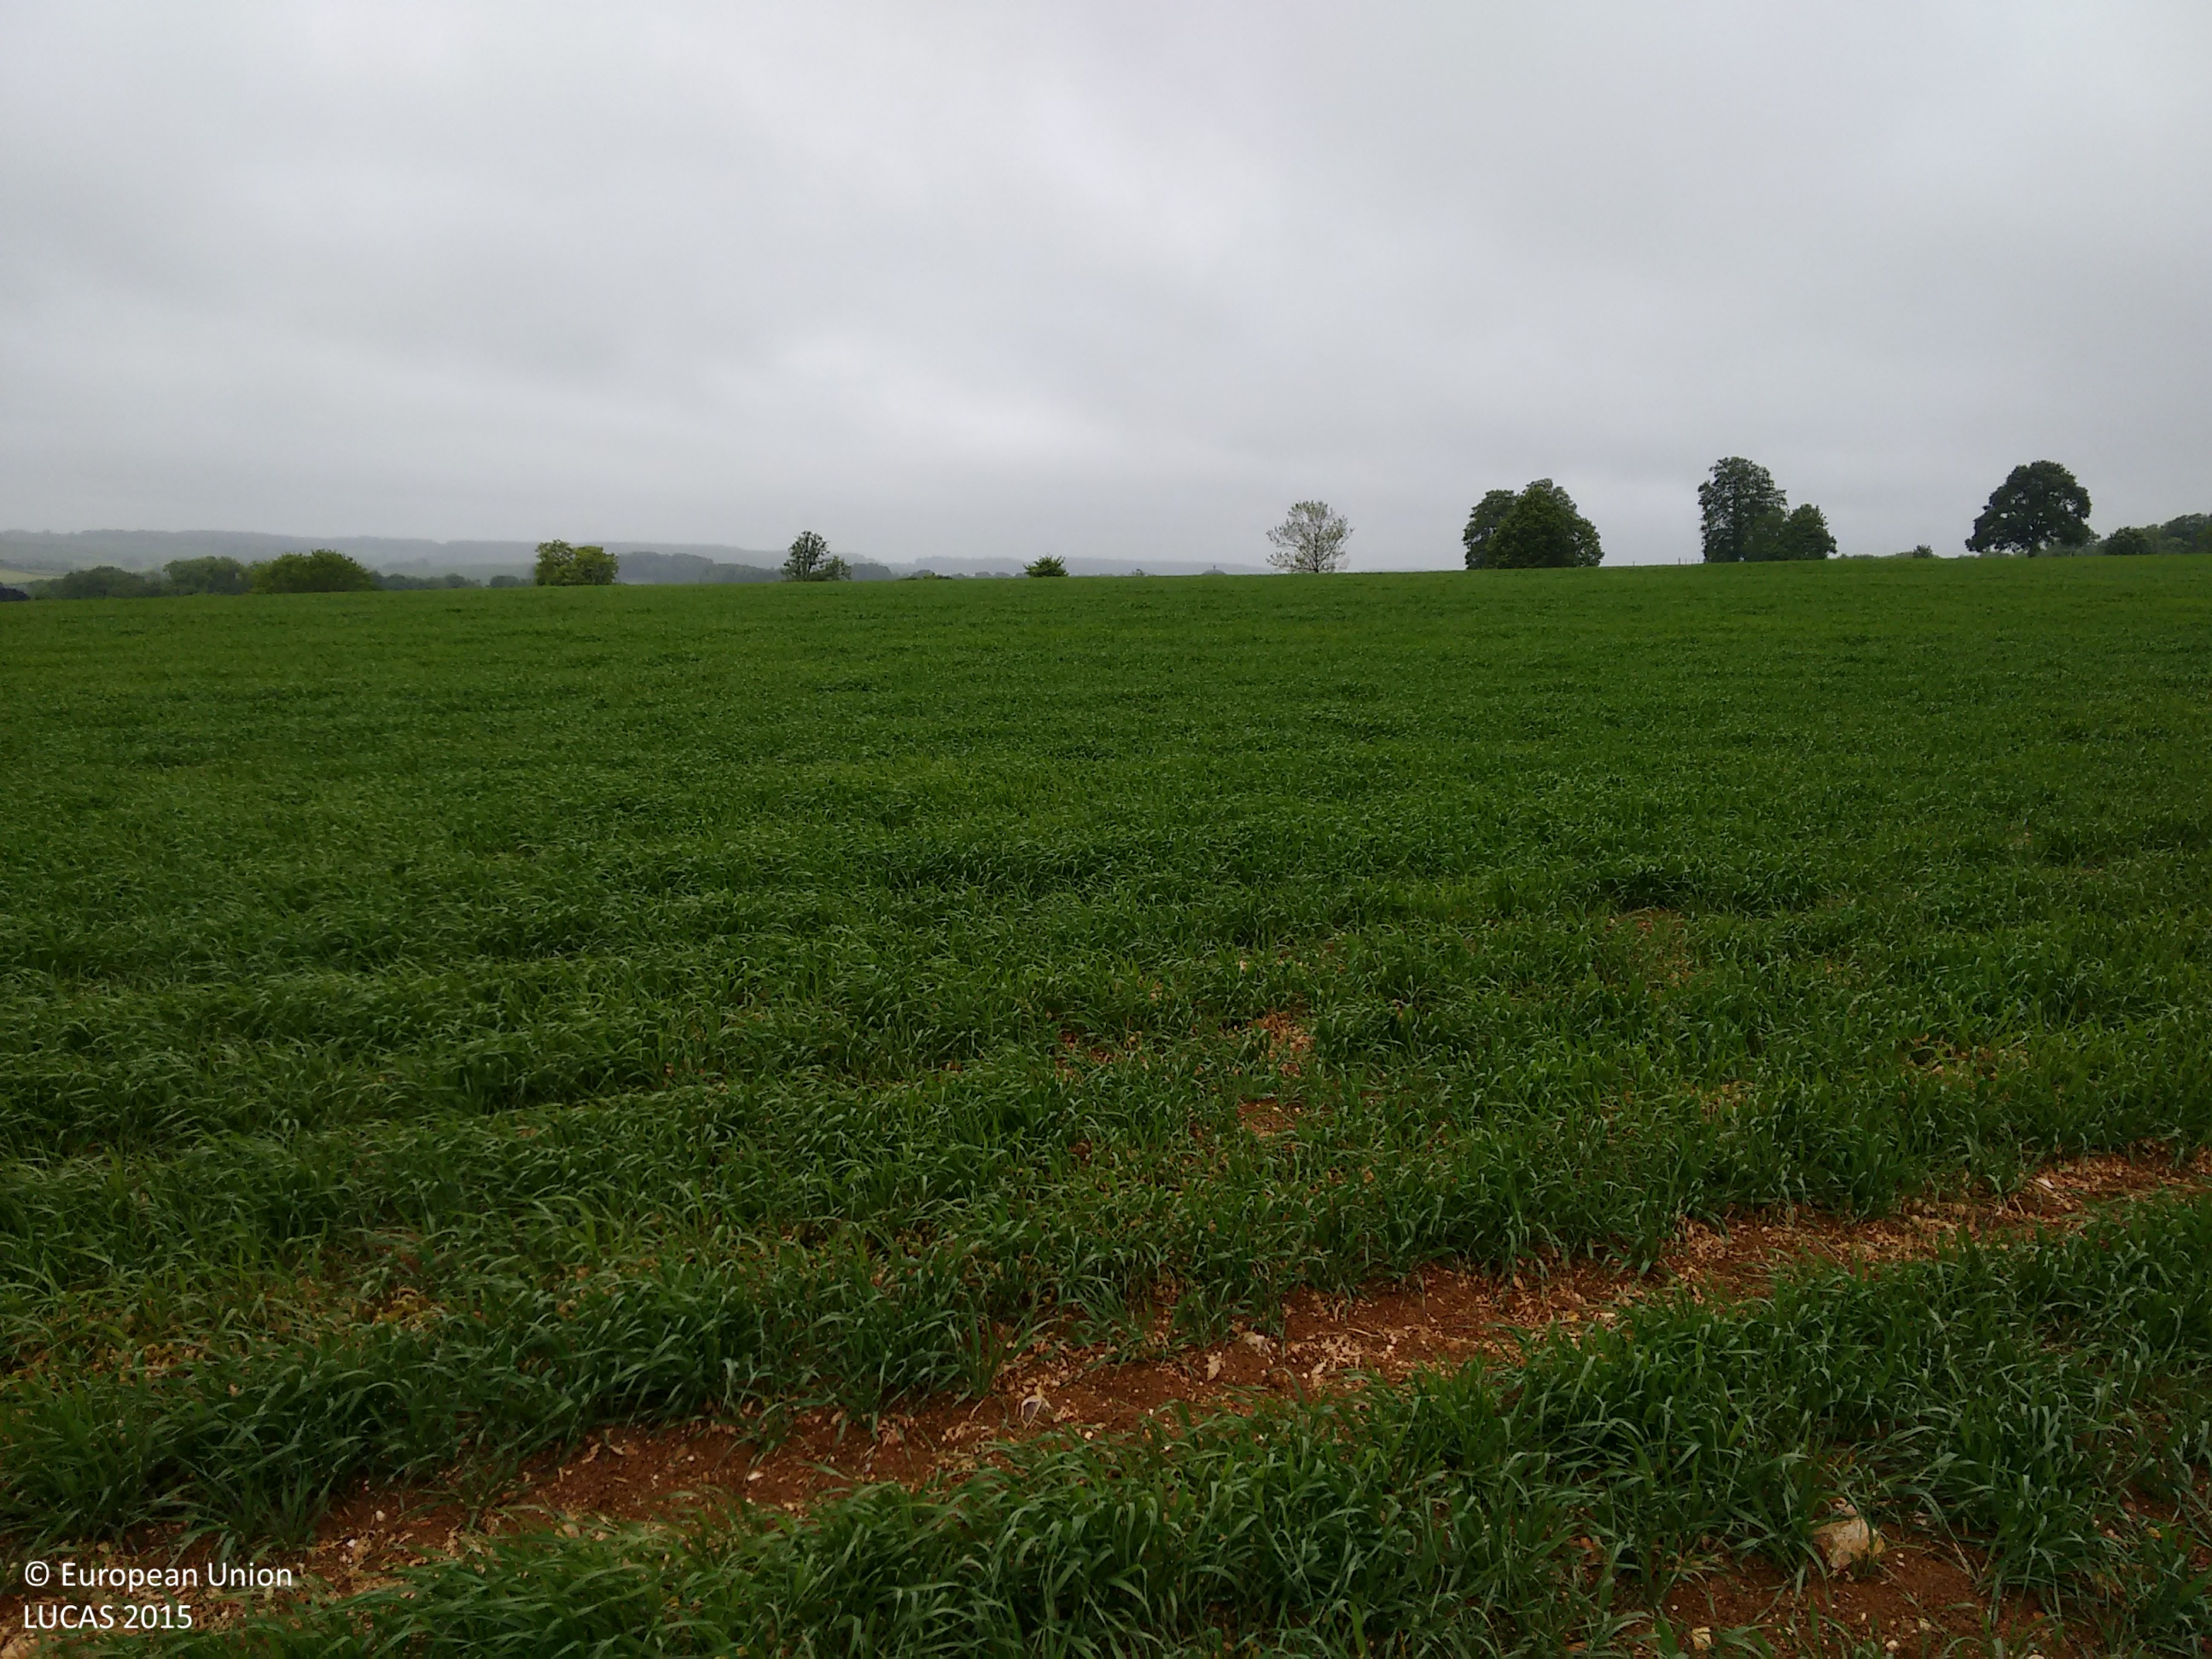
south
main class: Cropland
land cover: Barley
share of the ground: 50 - 75 %
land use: Agriculture (excluding fallow land and kitchen gardens)
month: June
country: GB
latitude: 51.1803
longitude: -1.1328
